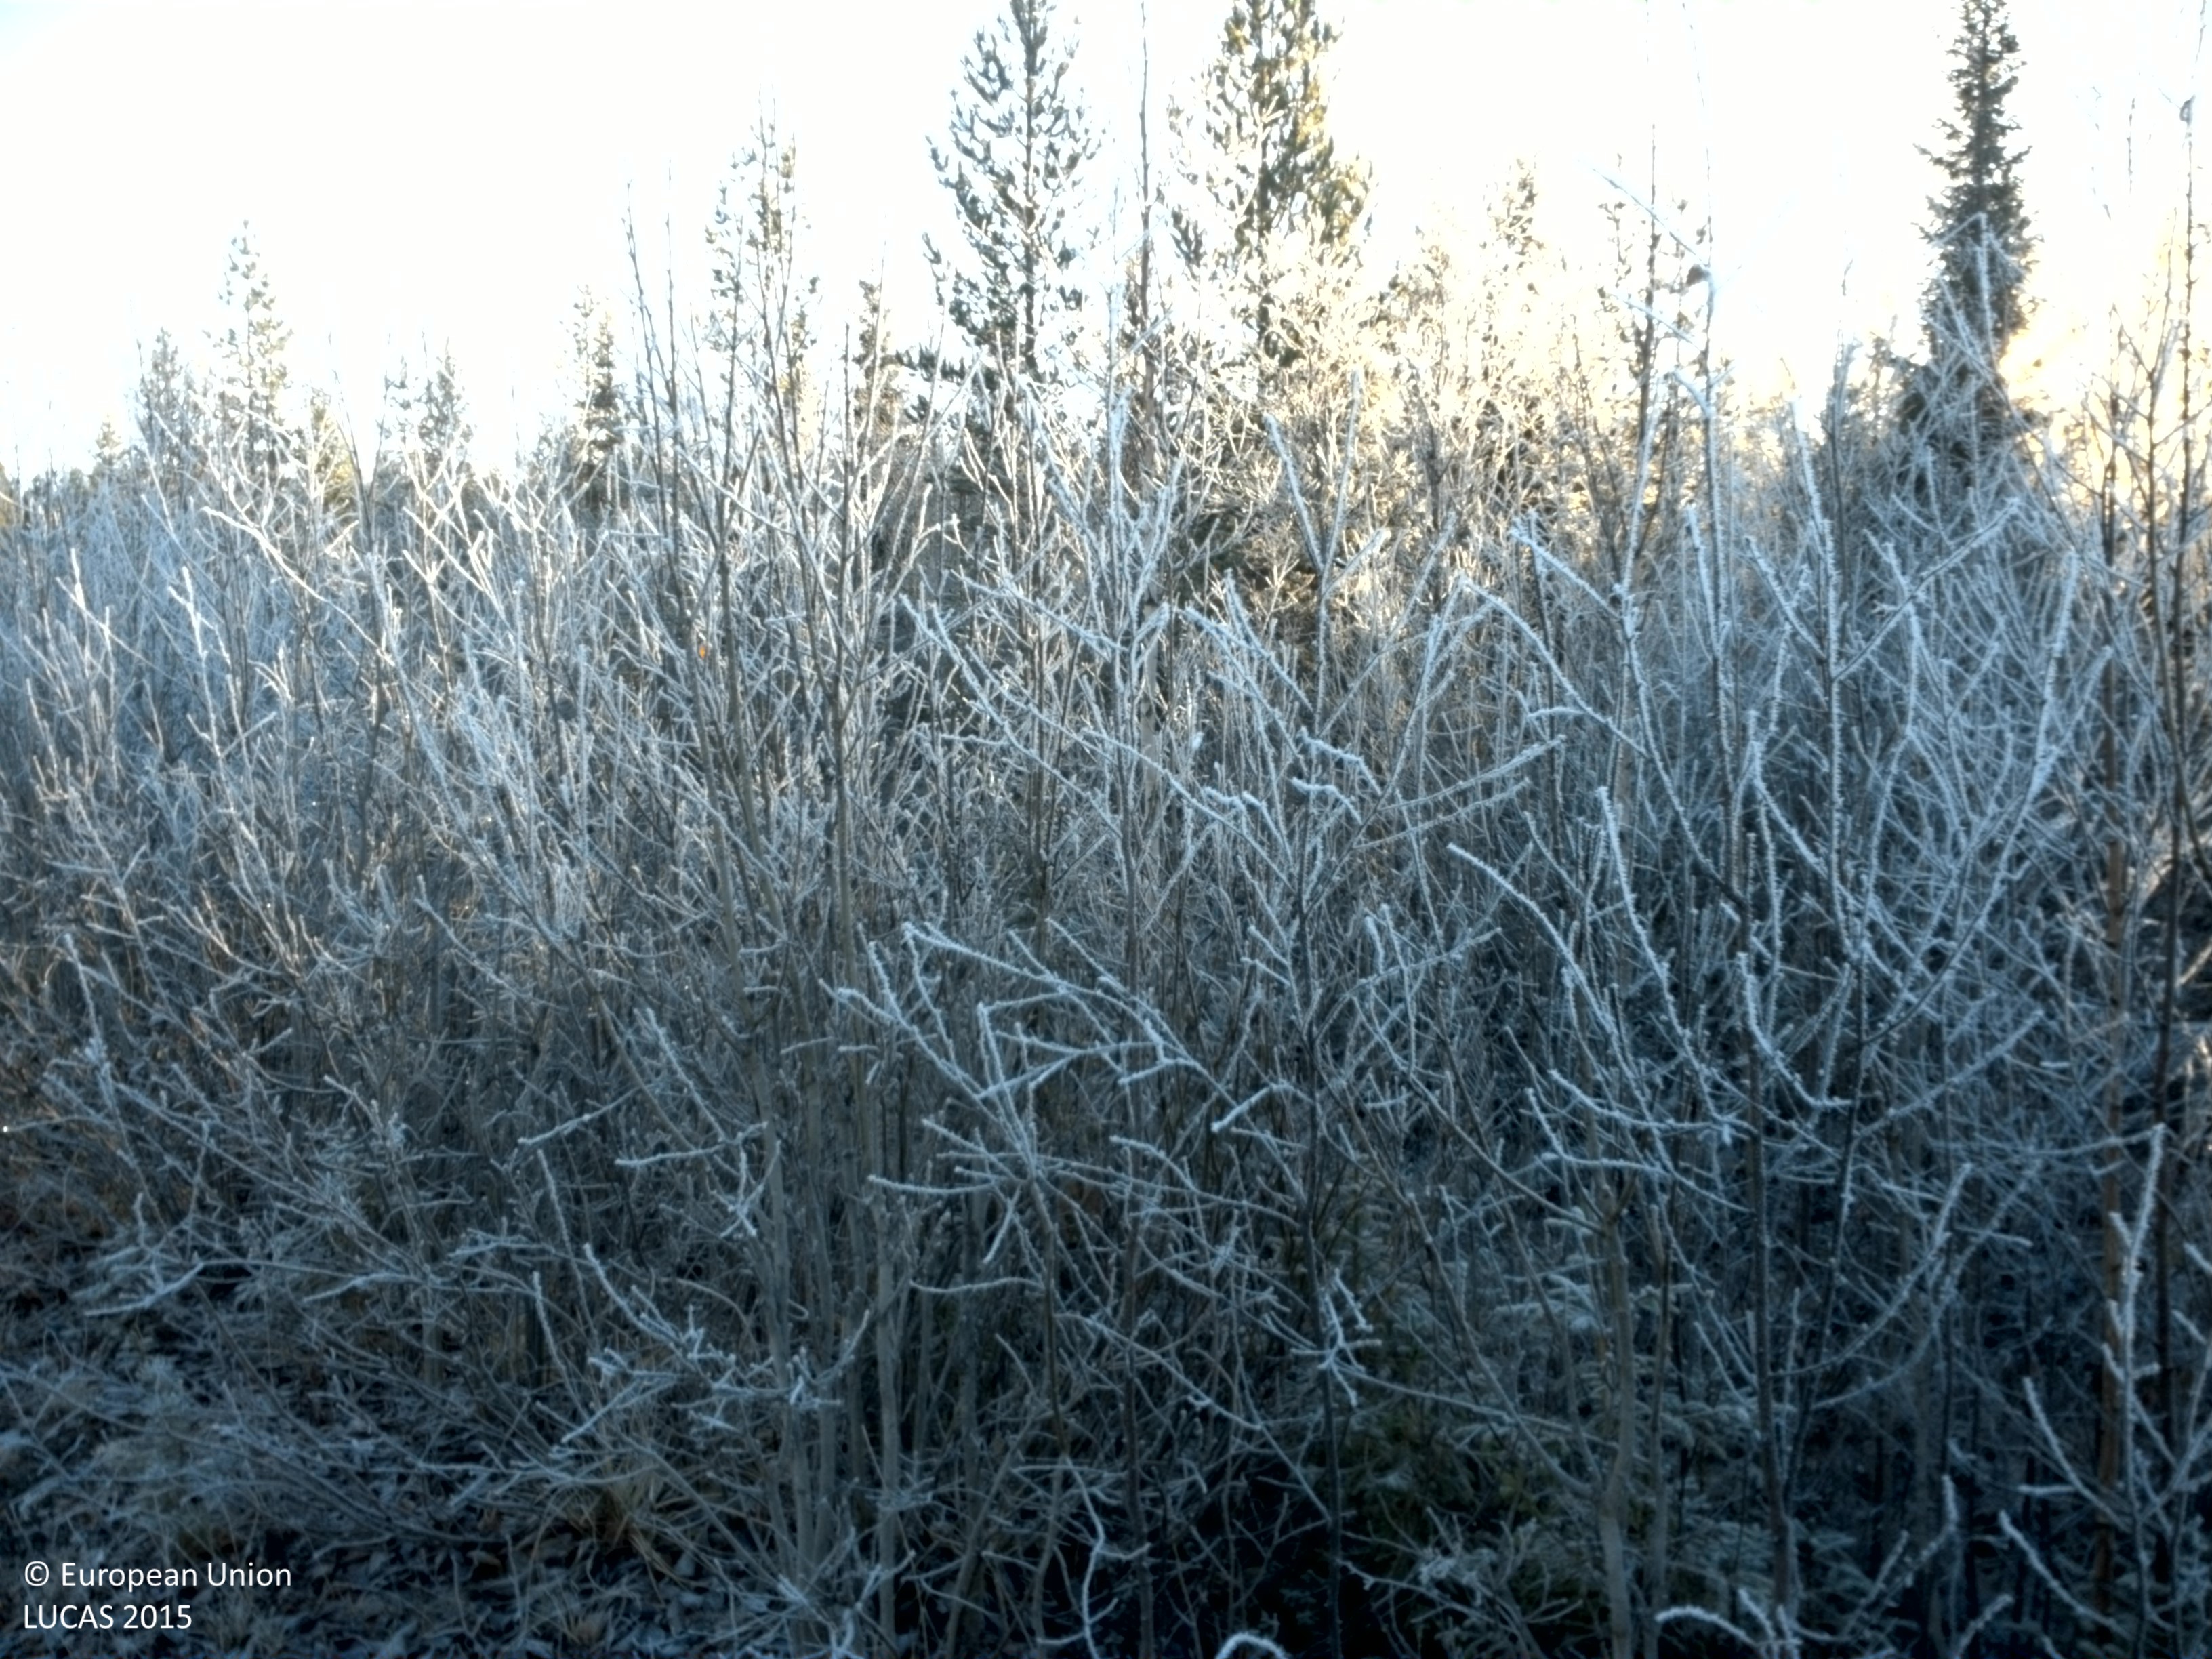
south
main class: Artificial land
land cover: Non built-up linear features
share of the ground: > 75 %
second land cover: Grassland without tree/shrub cover
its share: 10 - 25 %
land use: Road transport
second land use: Forestry
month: October
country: SE
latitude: 64.4406
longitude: 16.6363
